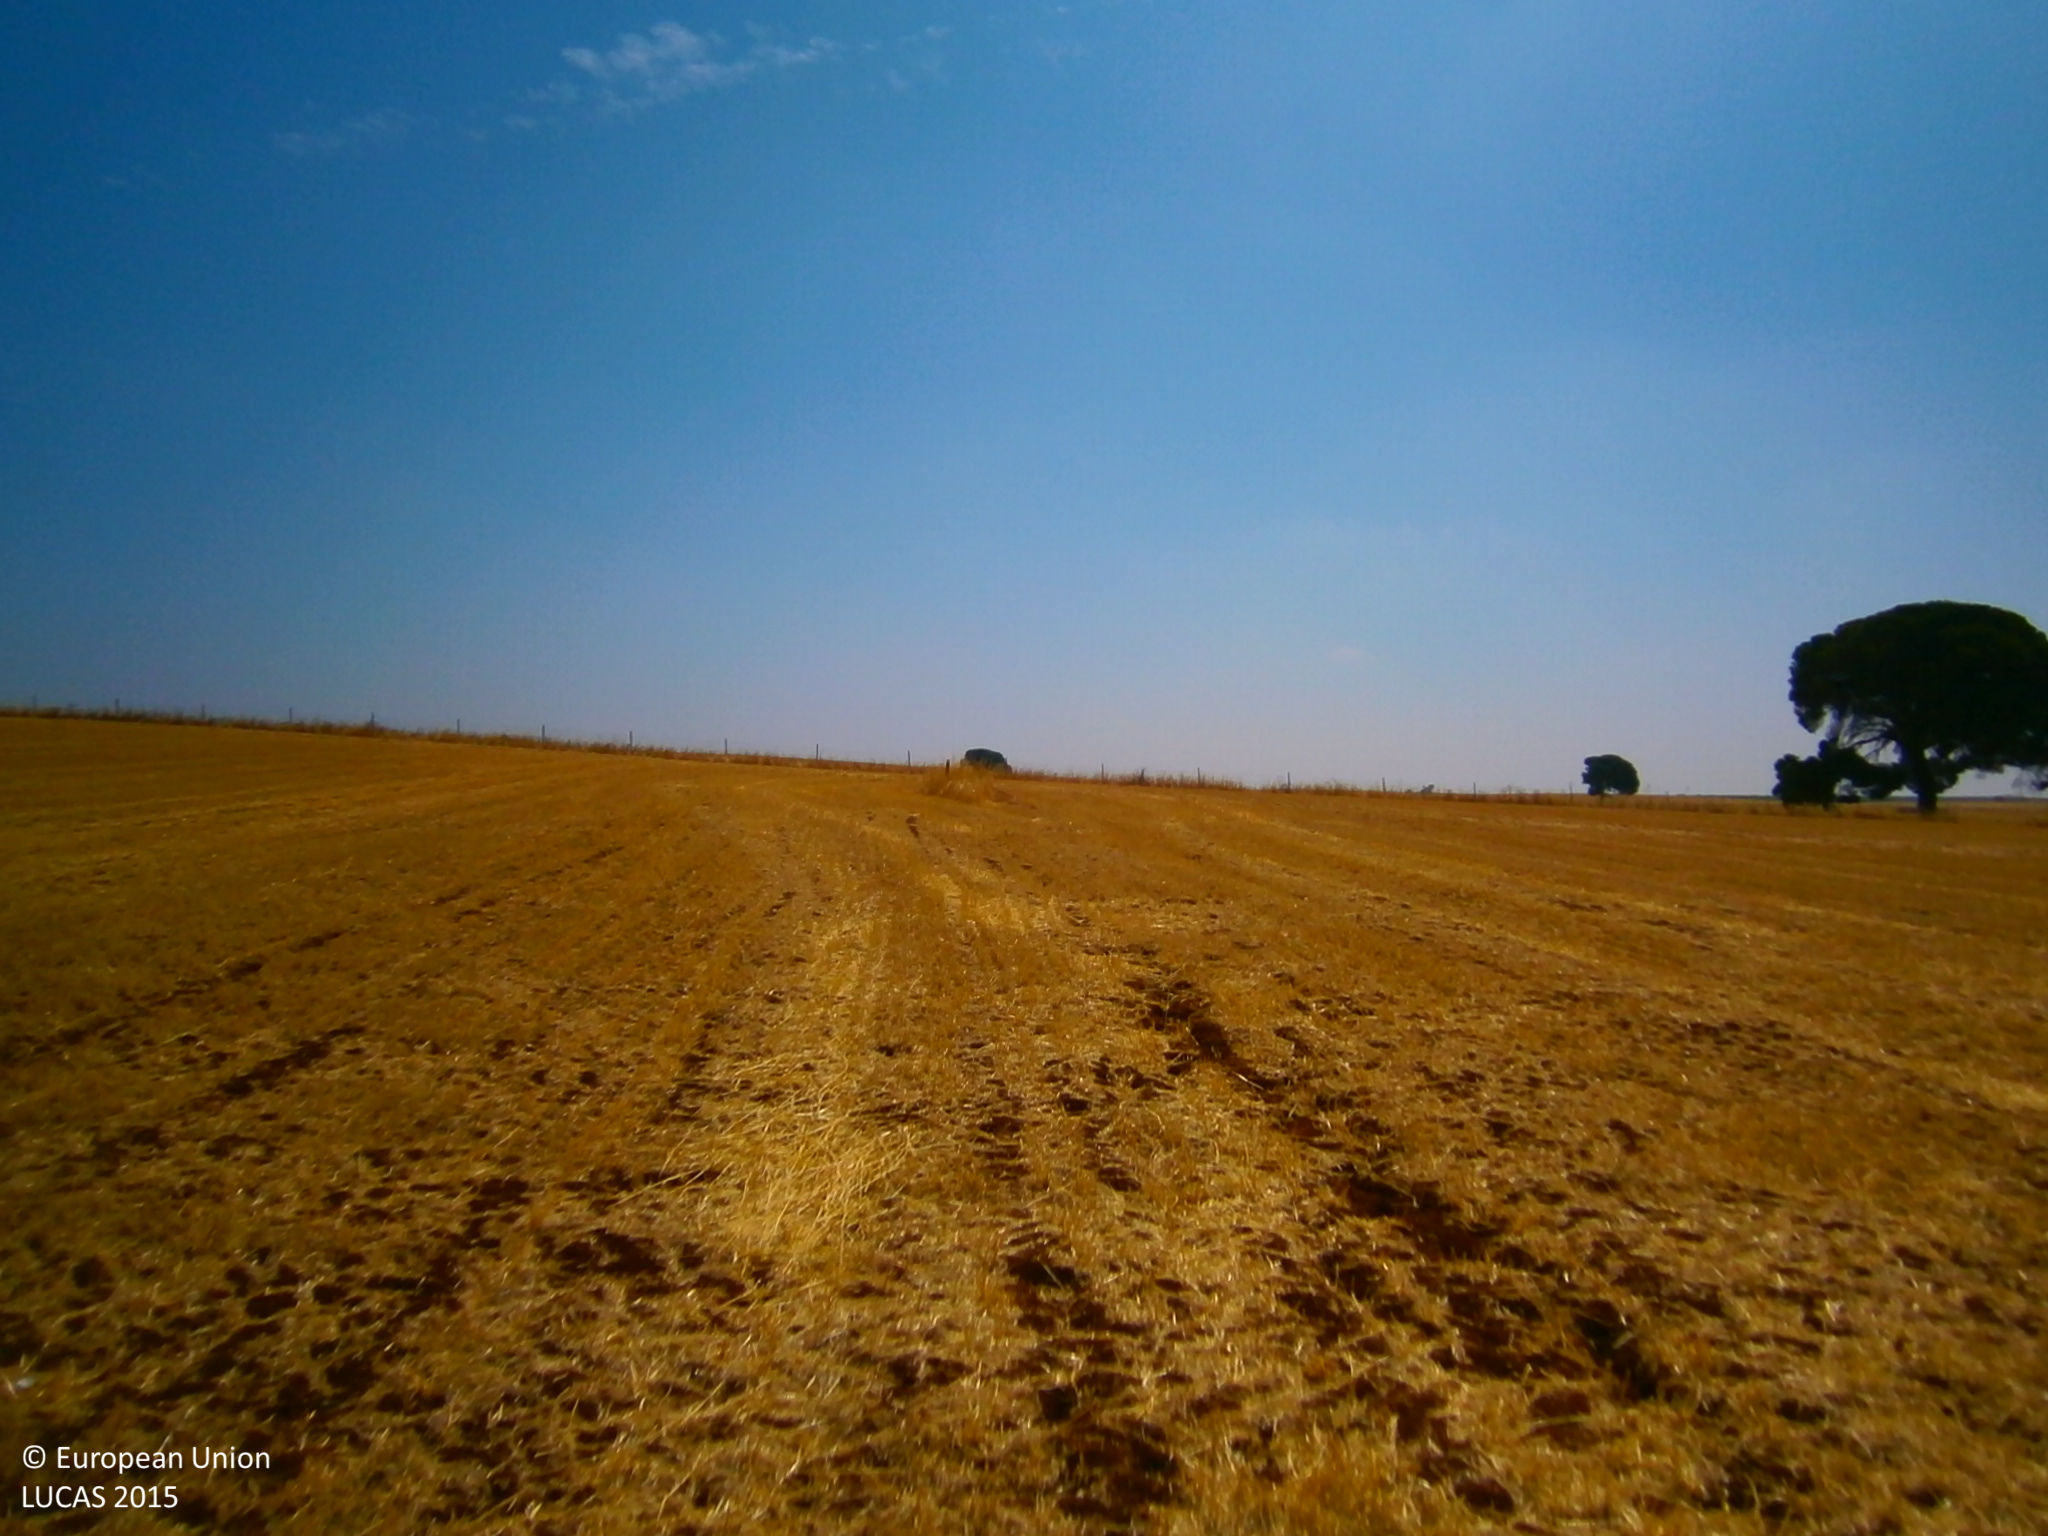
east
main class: Cropland
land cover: Barley
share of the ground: > 75 %
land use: Agriculture (excluding fallow land and kitchen gardens)
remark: Harvested field
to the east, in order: Barley; Tracks; Fences; Barley
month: July
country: ES
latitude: 38.7483
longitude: -6.9227
